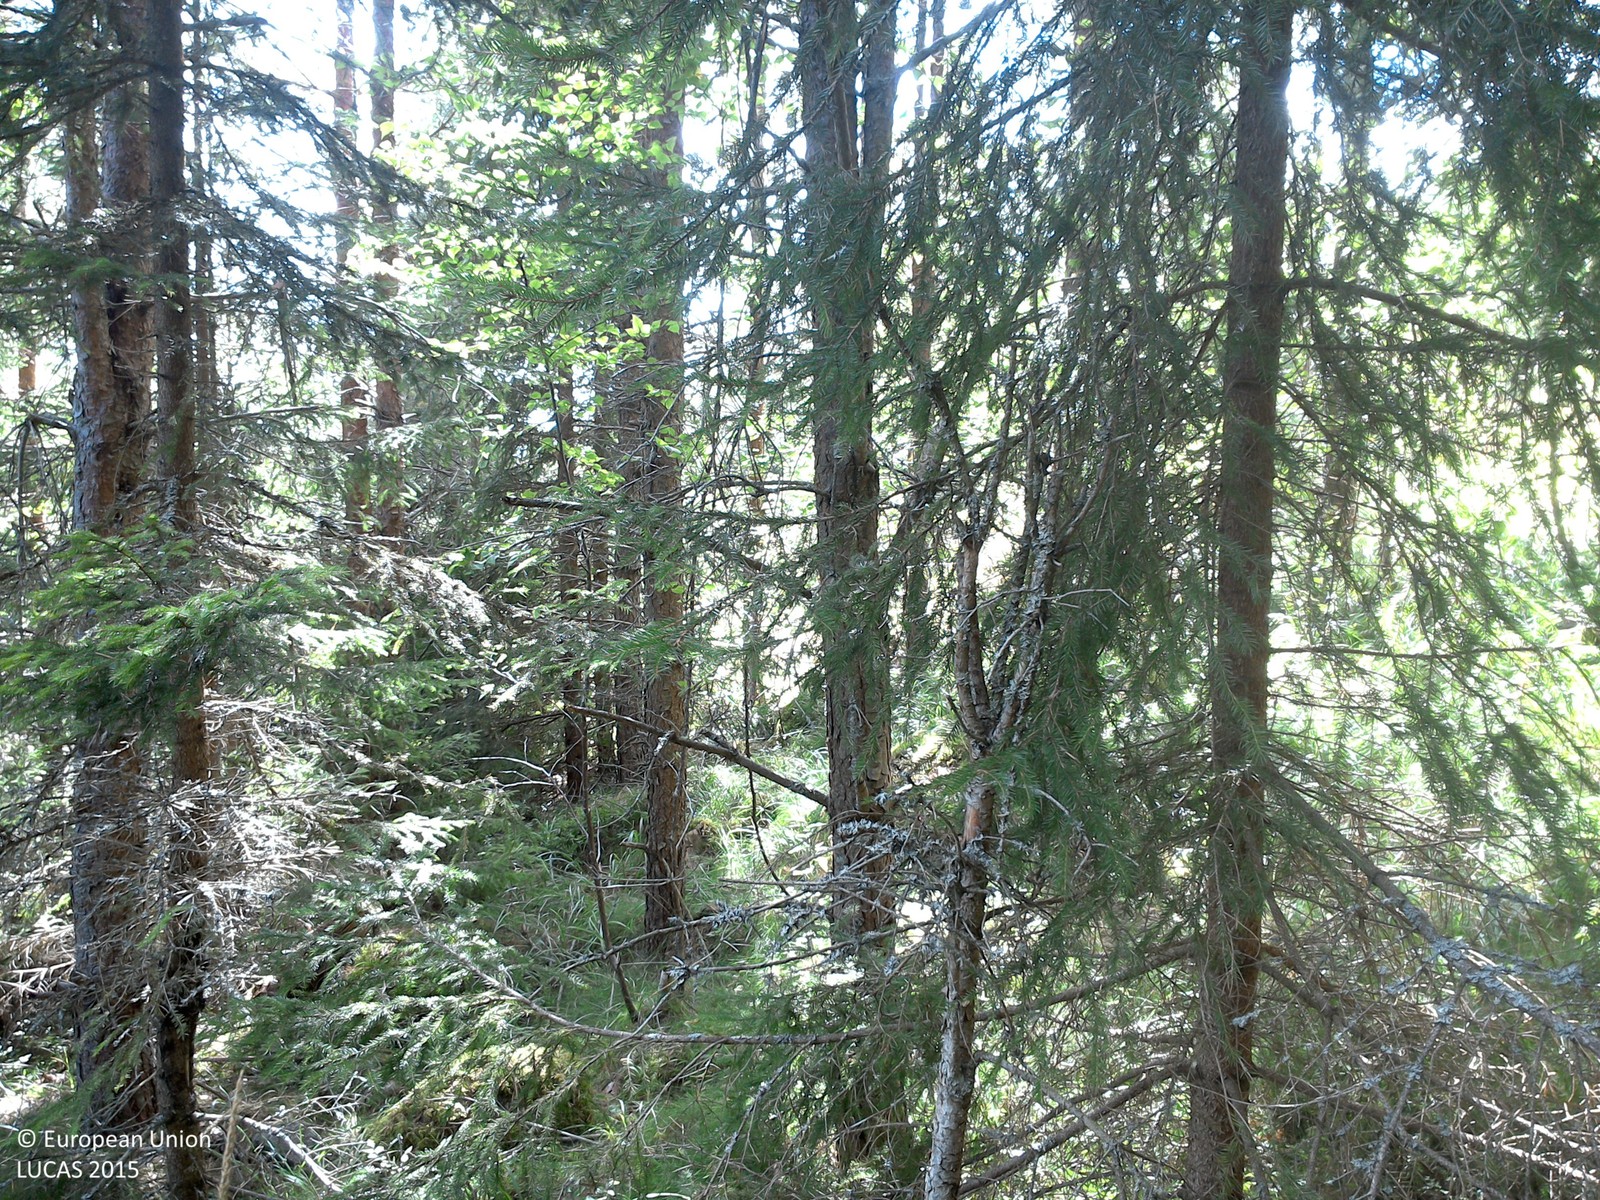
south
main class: Woodland
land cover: Pine dominated mixed woodland
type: boreal forest
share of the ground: 50 - 75 %
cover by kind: coniferous forest trees 50 %, broadleaved forest trees 20 %, herbaceous plants 20 %, lichens and mosses 10 %
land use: Forestry
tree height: > 5 m
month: August
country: SE
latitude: 57.9053
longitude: 15.5814
